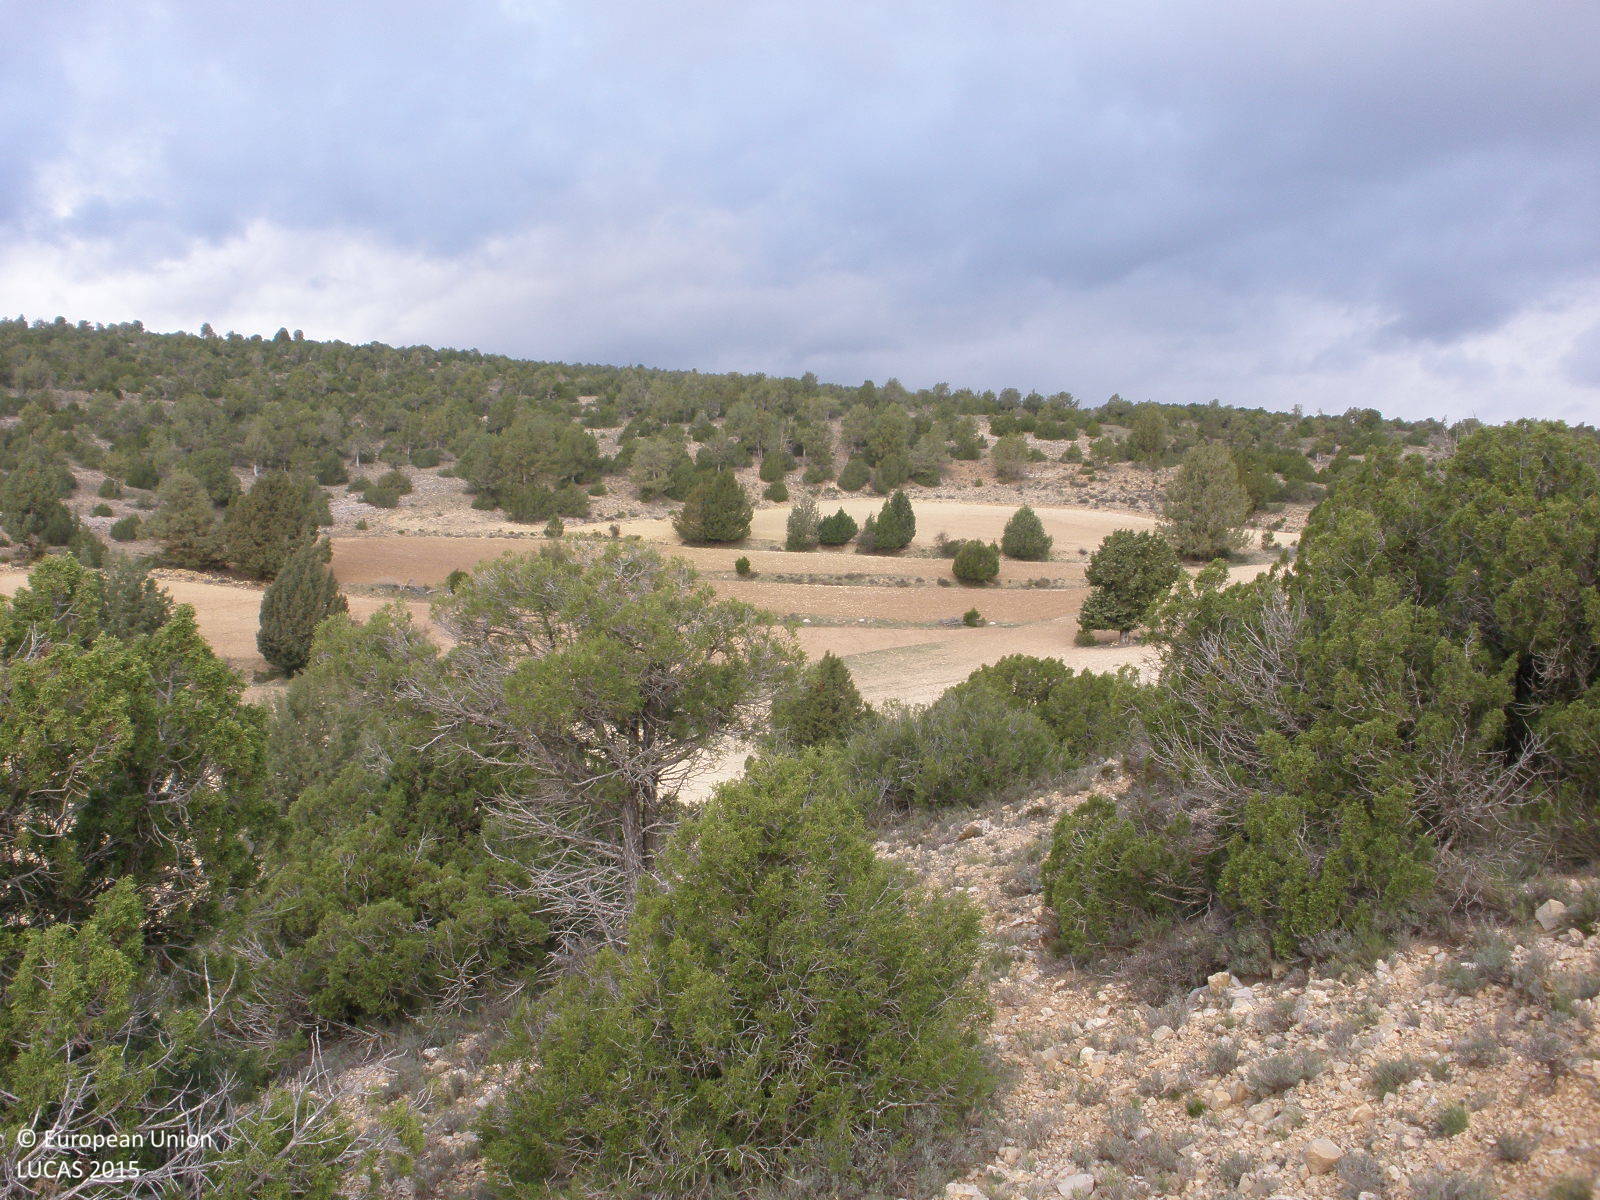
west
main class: Woodland
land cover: Other coniferous woodland
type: coniferous forest of the mediterranean region
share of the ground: > 75 %
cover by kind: coniferous forest trees 40 %, shrubs 30 %, consolidated bare surface 30 %
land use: Semi-natural and natural areas not in use
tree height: < 5 m
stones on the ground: > 50 %
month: April
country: ES
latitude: 40.3475
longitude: -1.2551
